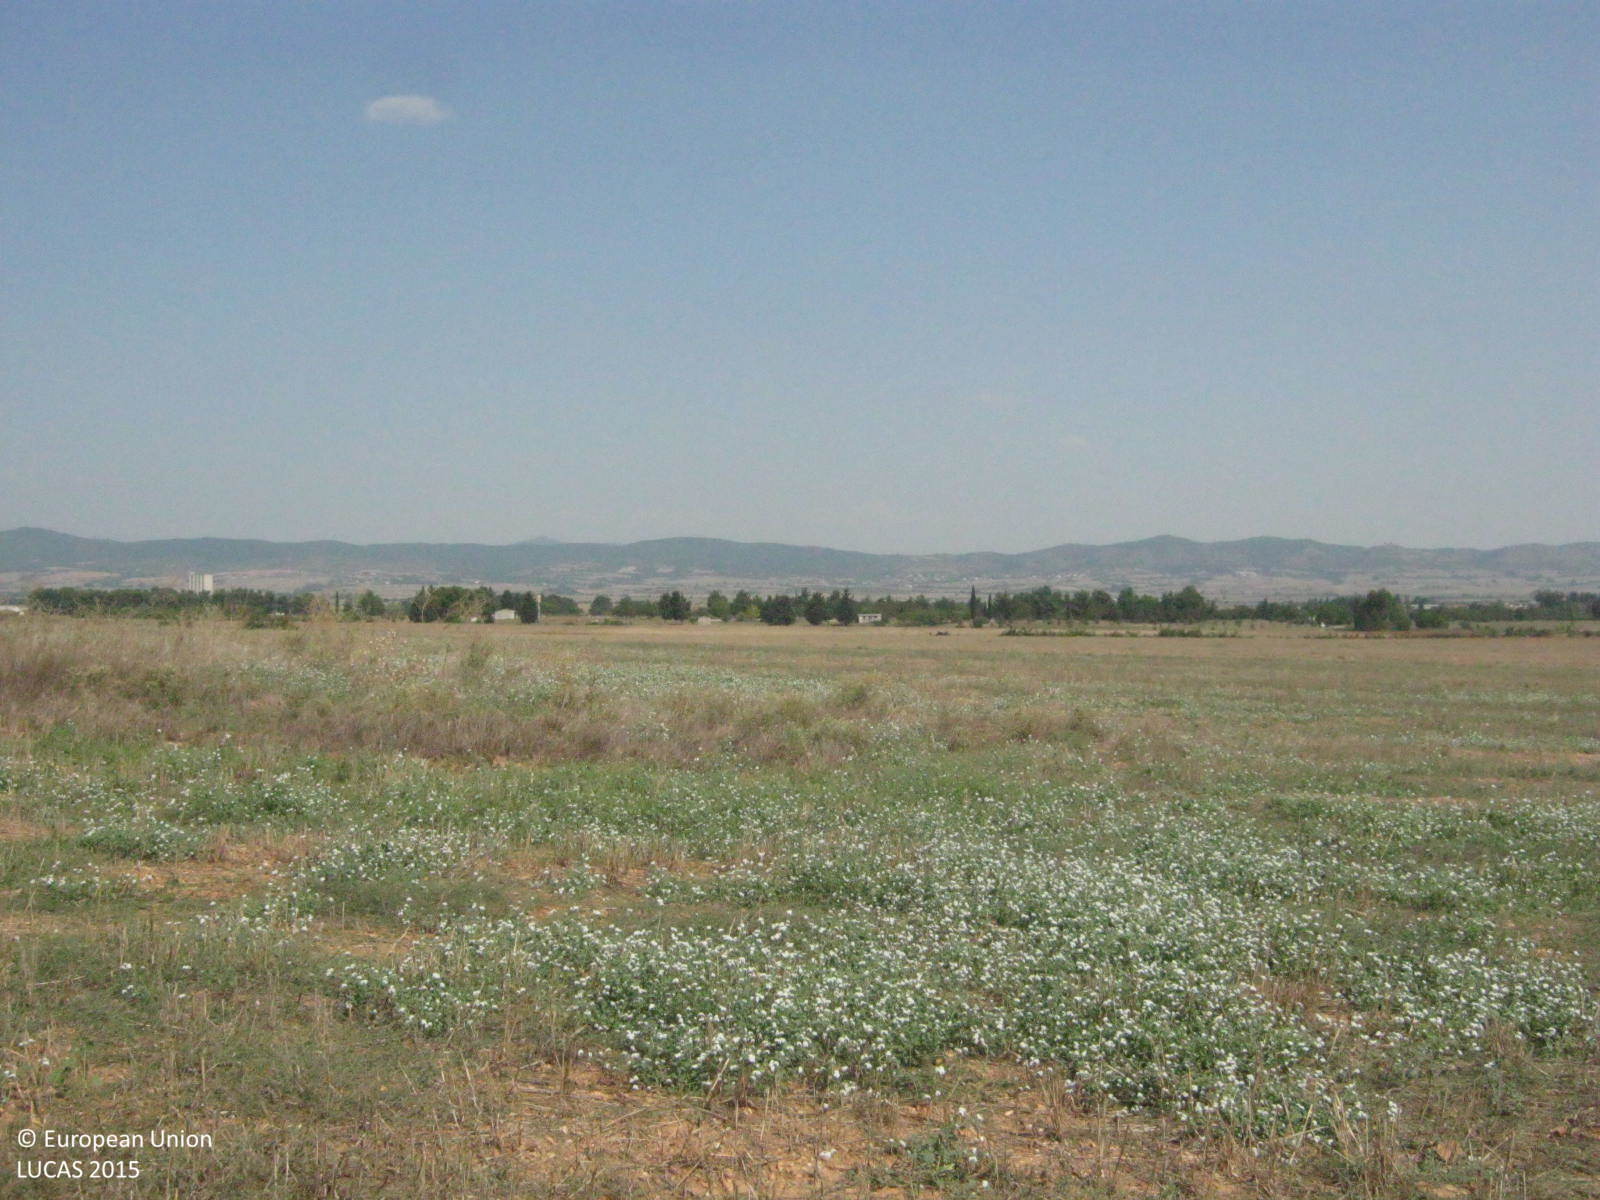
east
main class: Grassland
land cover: Spontaneously vegetated surfaces
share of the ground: > 75 %
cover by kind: herbaceous plants 100 %
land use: Fallow land
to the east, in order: Spontaneously vegetated surfaces; Common wheat
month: August
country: GR
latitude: 41.0942
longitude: 22.7610
